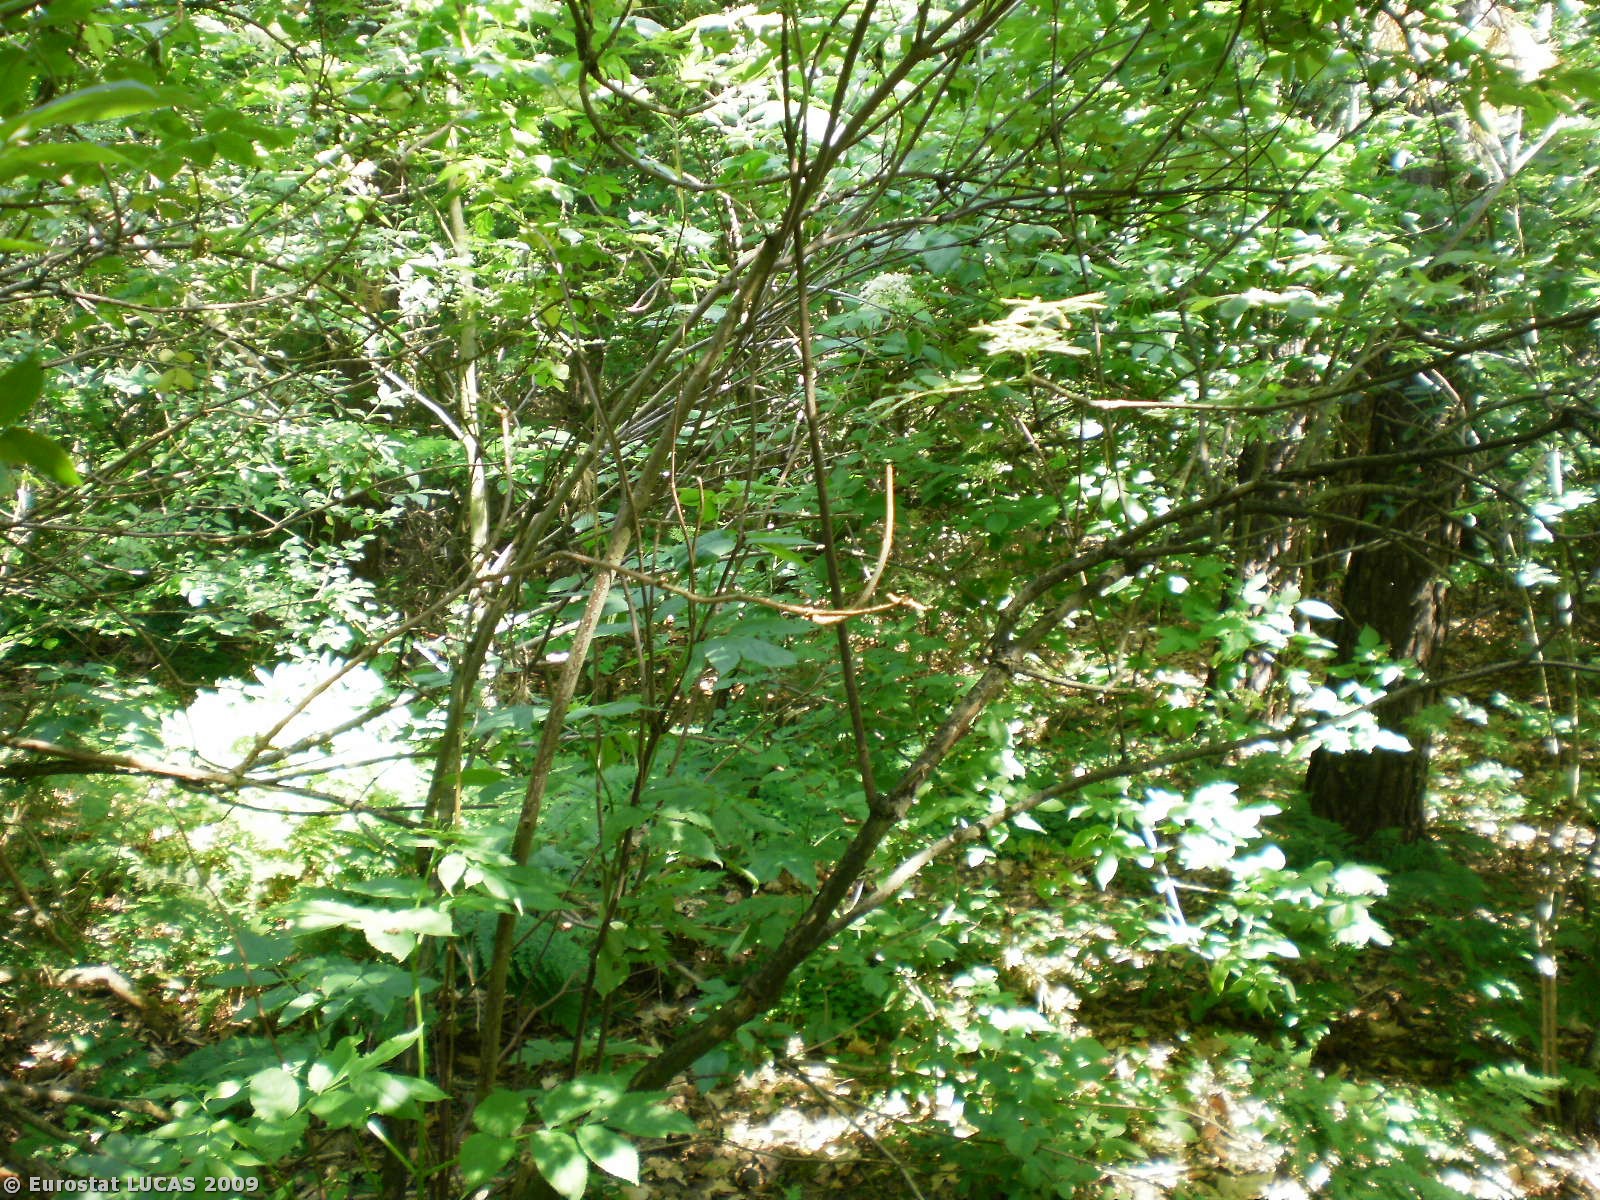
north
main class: Woodland
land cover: Mixed woodland
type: hemiboreal forest and nemoral coniferous forest and mixed broadleaved-coniferous forest
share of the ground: > 75 %
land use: Forestry
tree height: > 5 m
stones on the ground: < 10 %
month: June
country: PL
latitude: 54.5521
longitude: 17.3225
